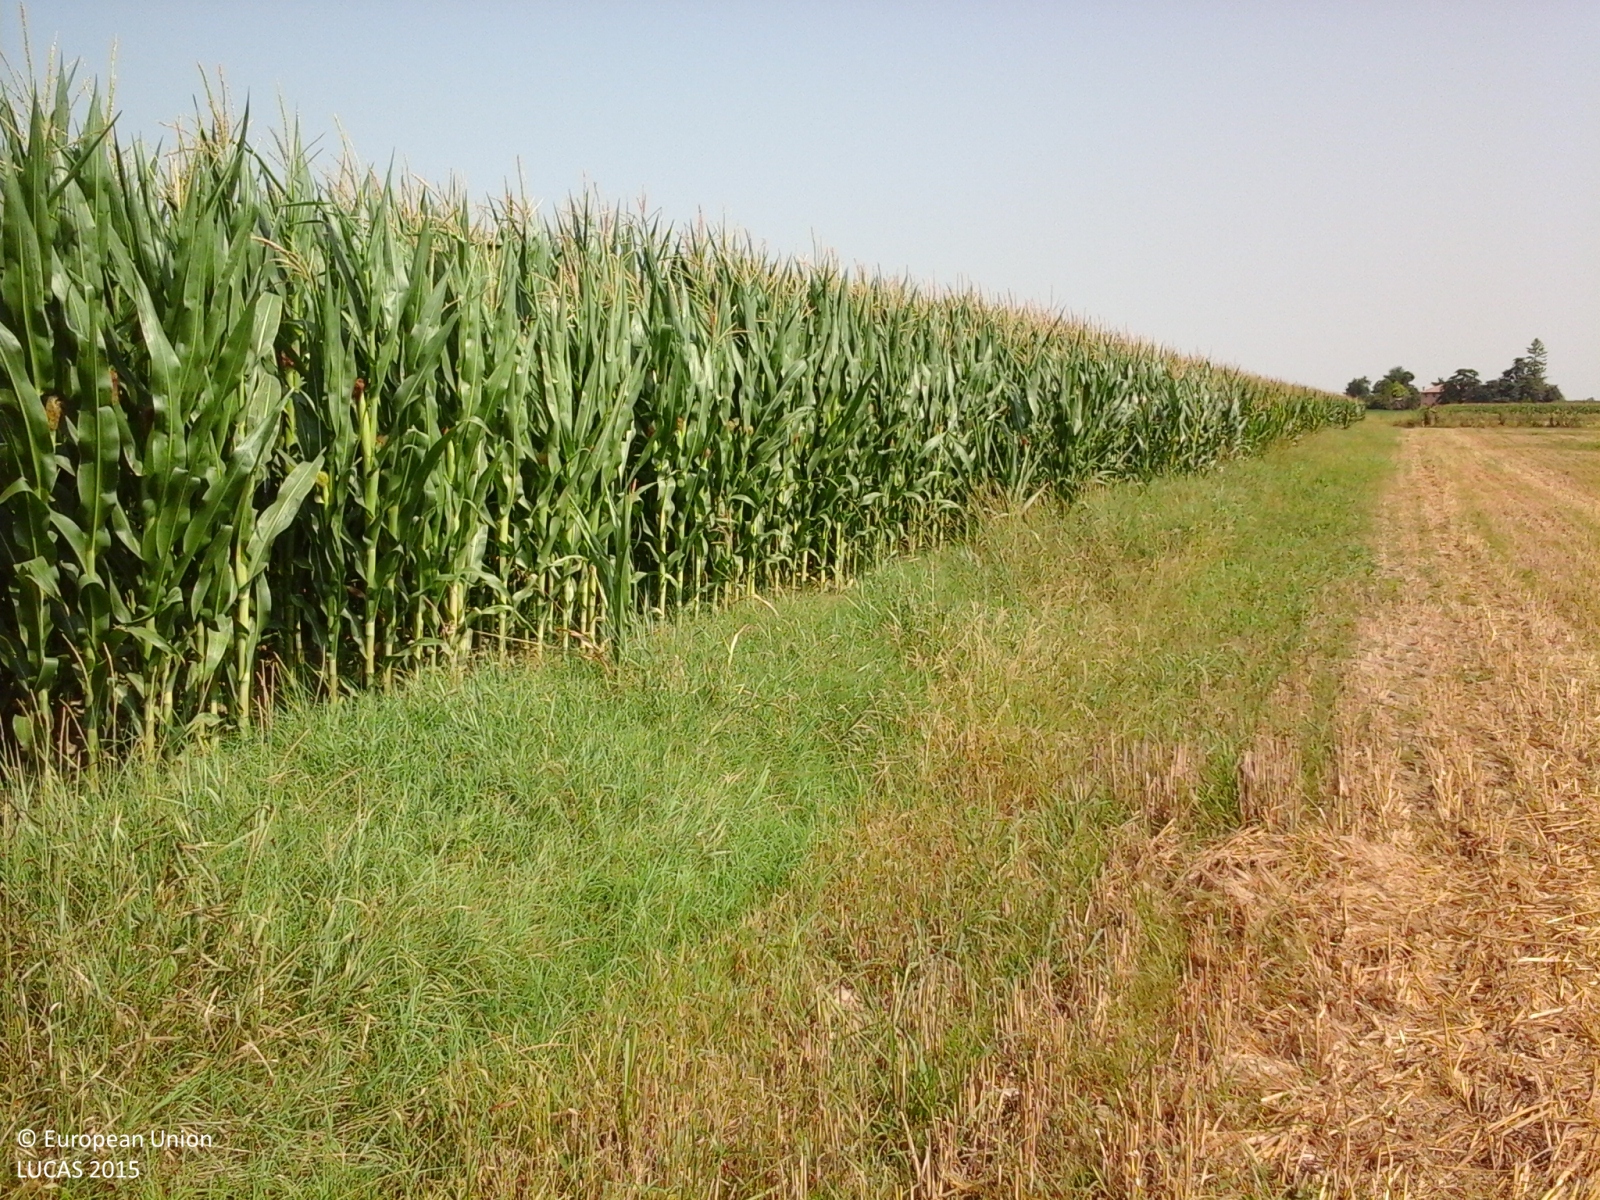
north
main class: Cropland
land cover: Maize
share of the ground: > 75 %
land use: Agriculture (excluding fallow land and kitchen gardens)
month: July
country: IT
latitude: 44.5900
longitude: 11.6467
